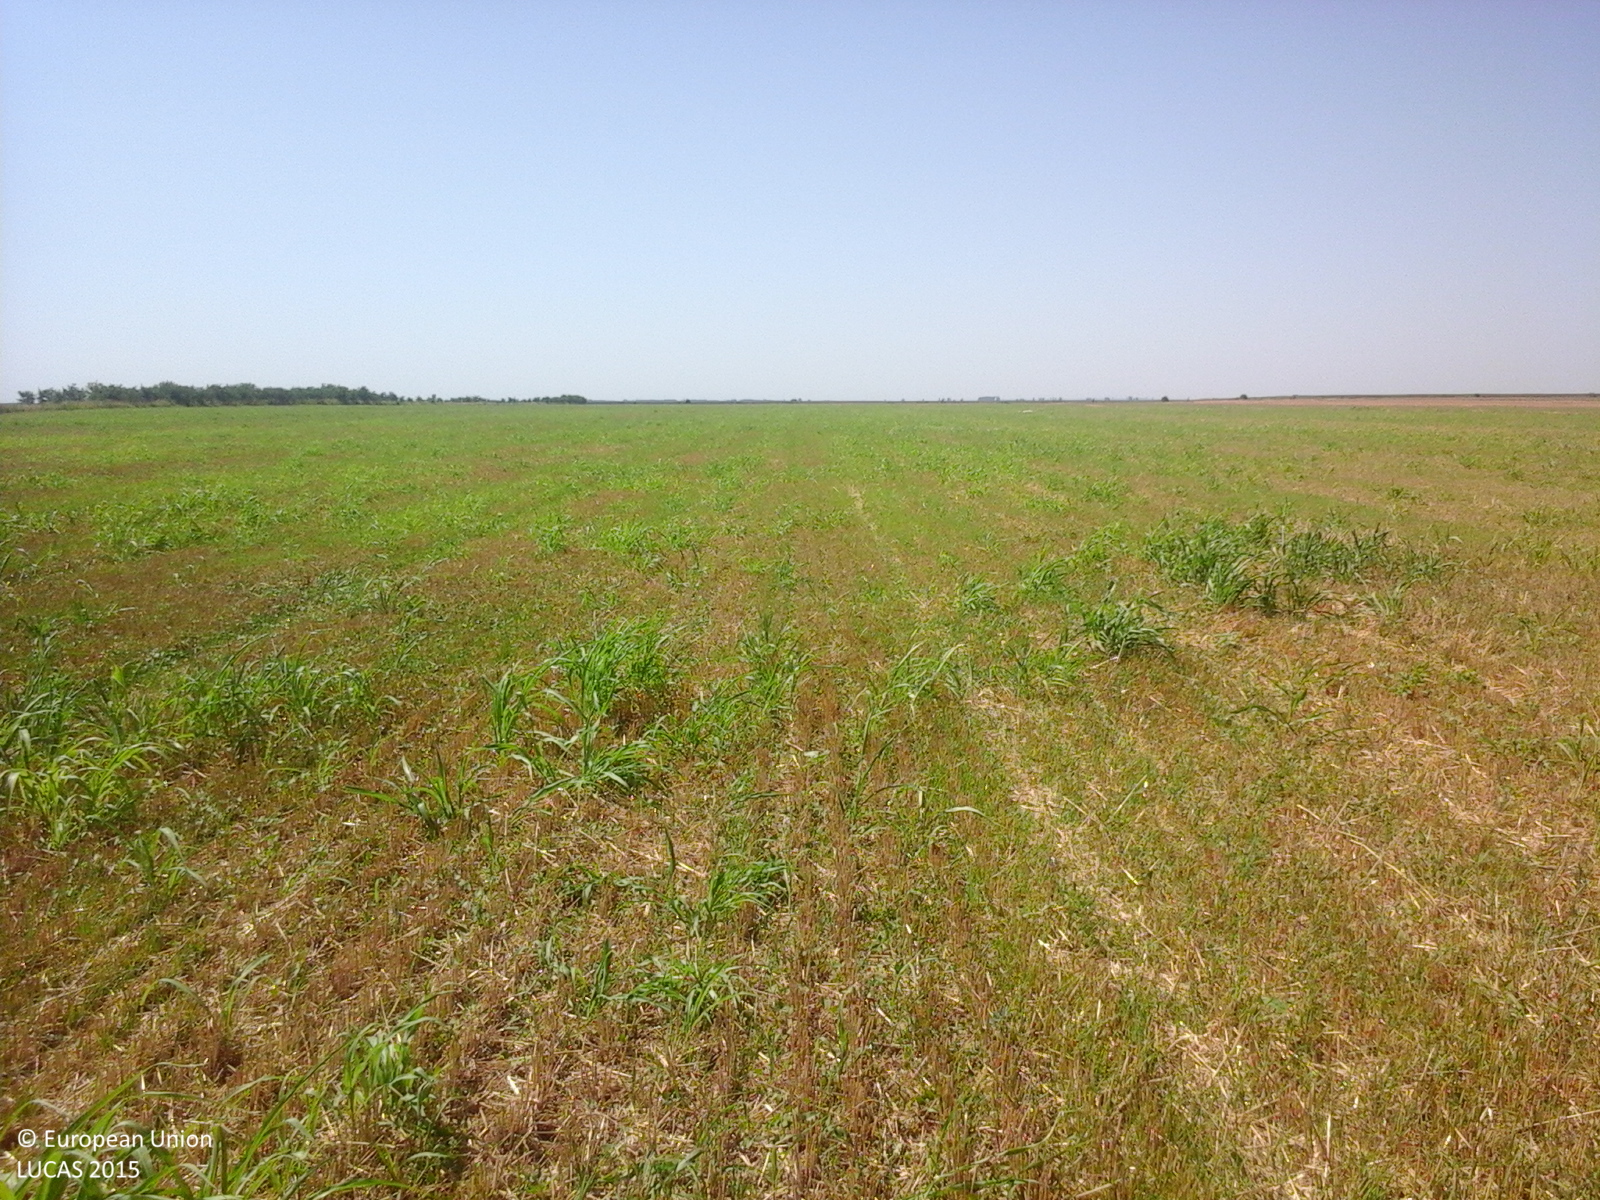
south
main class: Cropland
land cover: Common wheat
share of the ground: 50 - 75 %
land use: Agriculture (excluding fallow land and kitchen gardens)
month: July
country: RO
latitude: 44.3797
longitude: 26.4935
